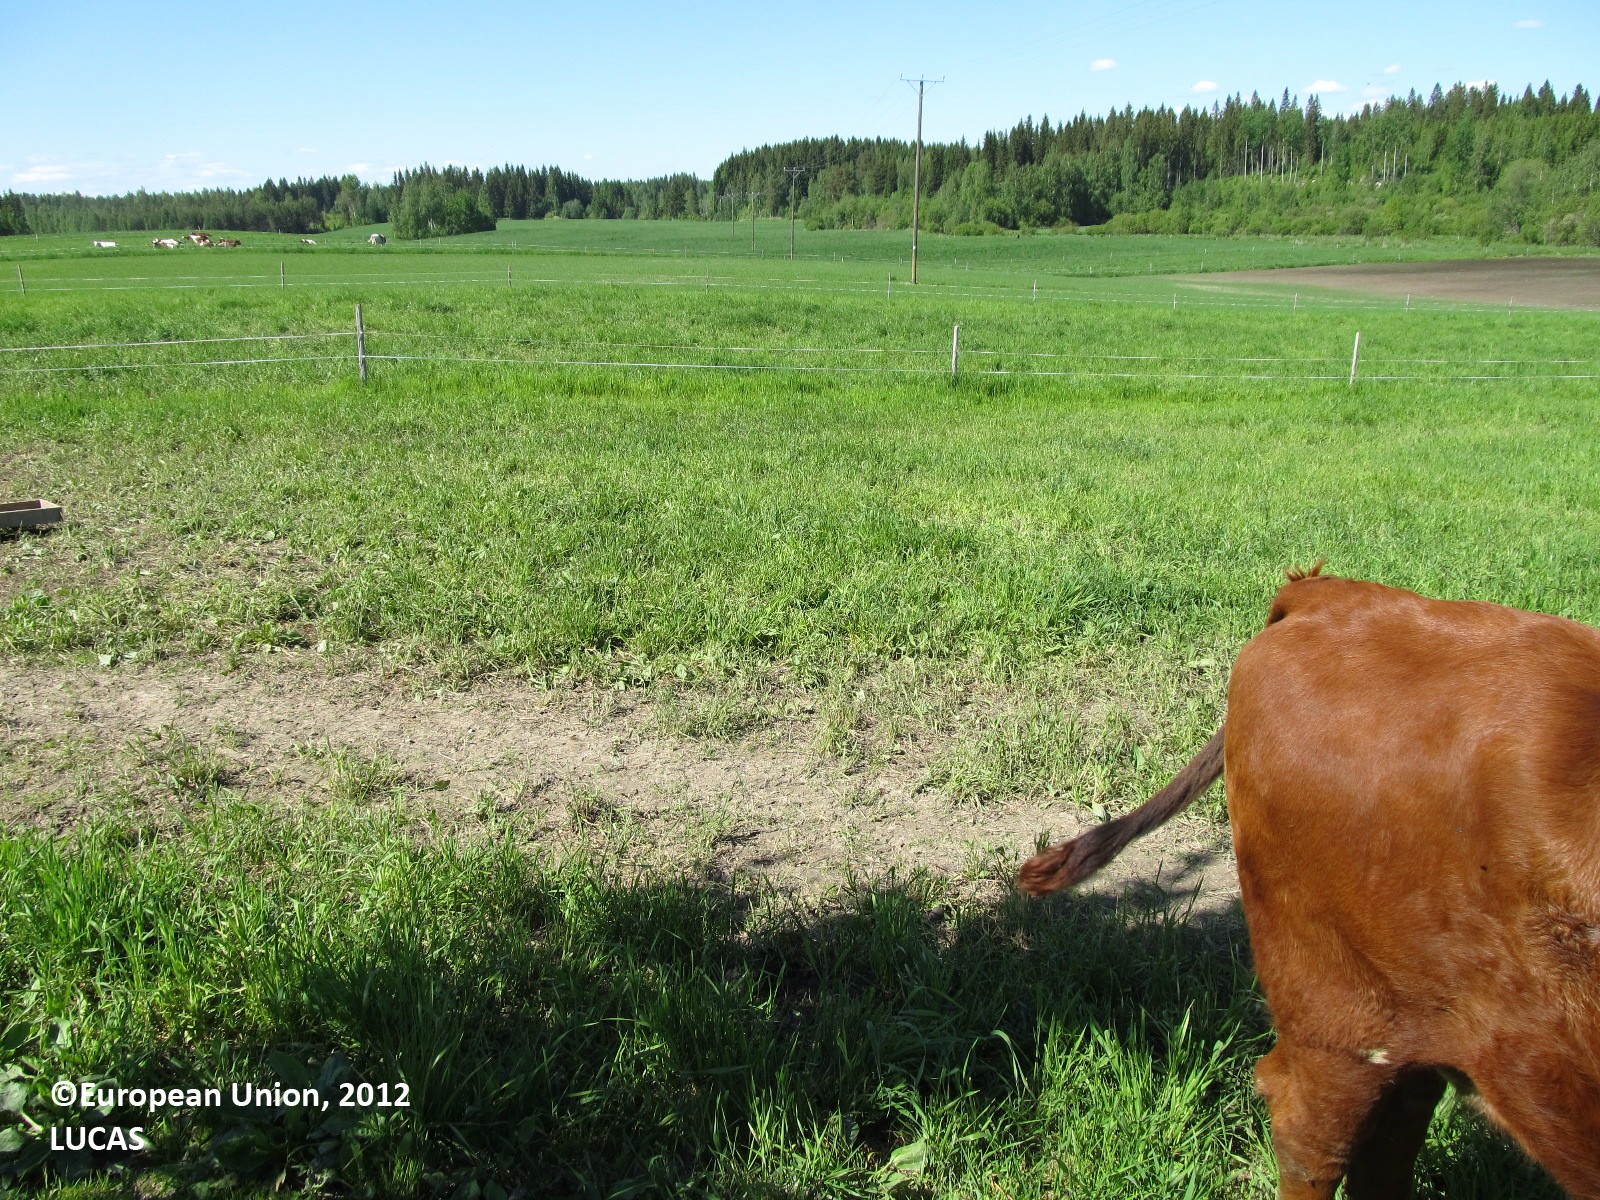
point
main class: Grassland
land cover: Grassland without tree/shrub cover
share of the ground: > 75 %
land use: Agriculture (excluding fallow land and kitchen gardens)
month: June
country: FI
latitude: 63.0323
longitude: 27.5772
